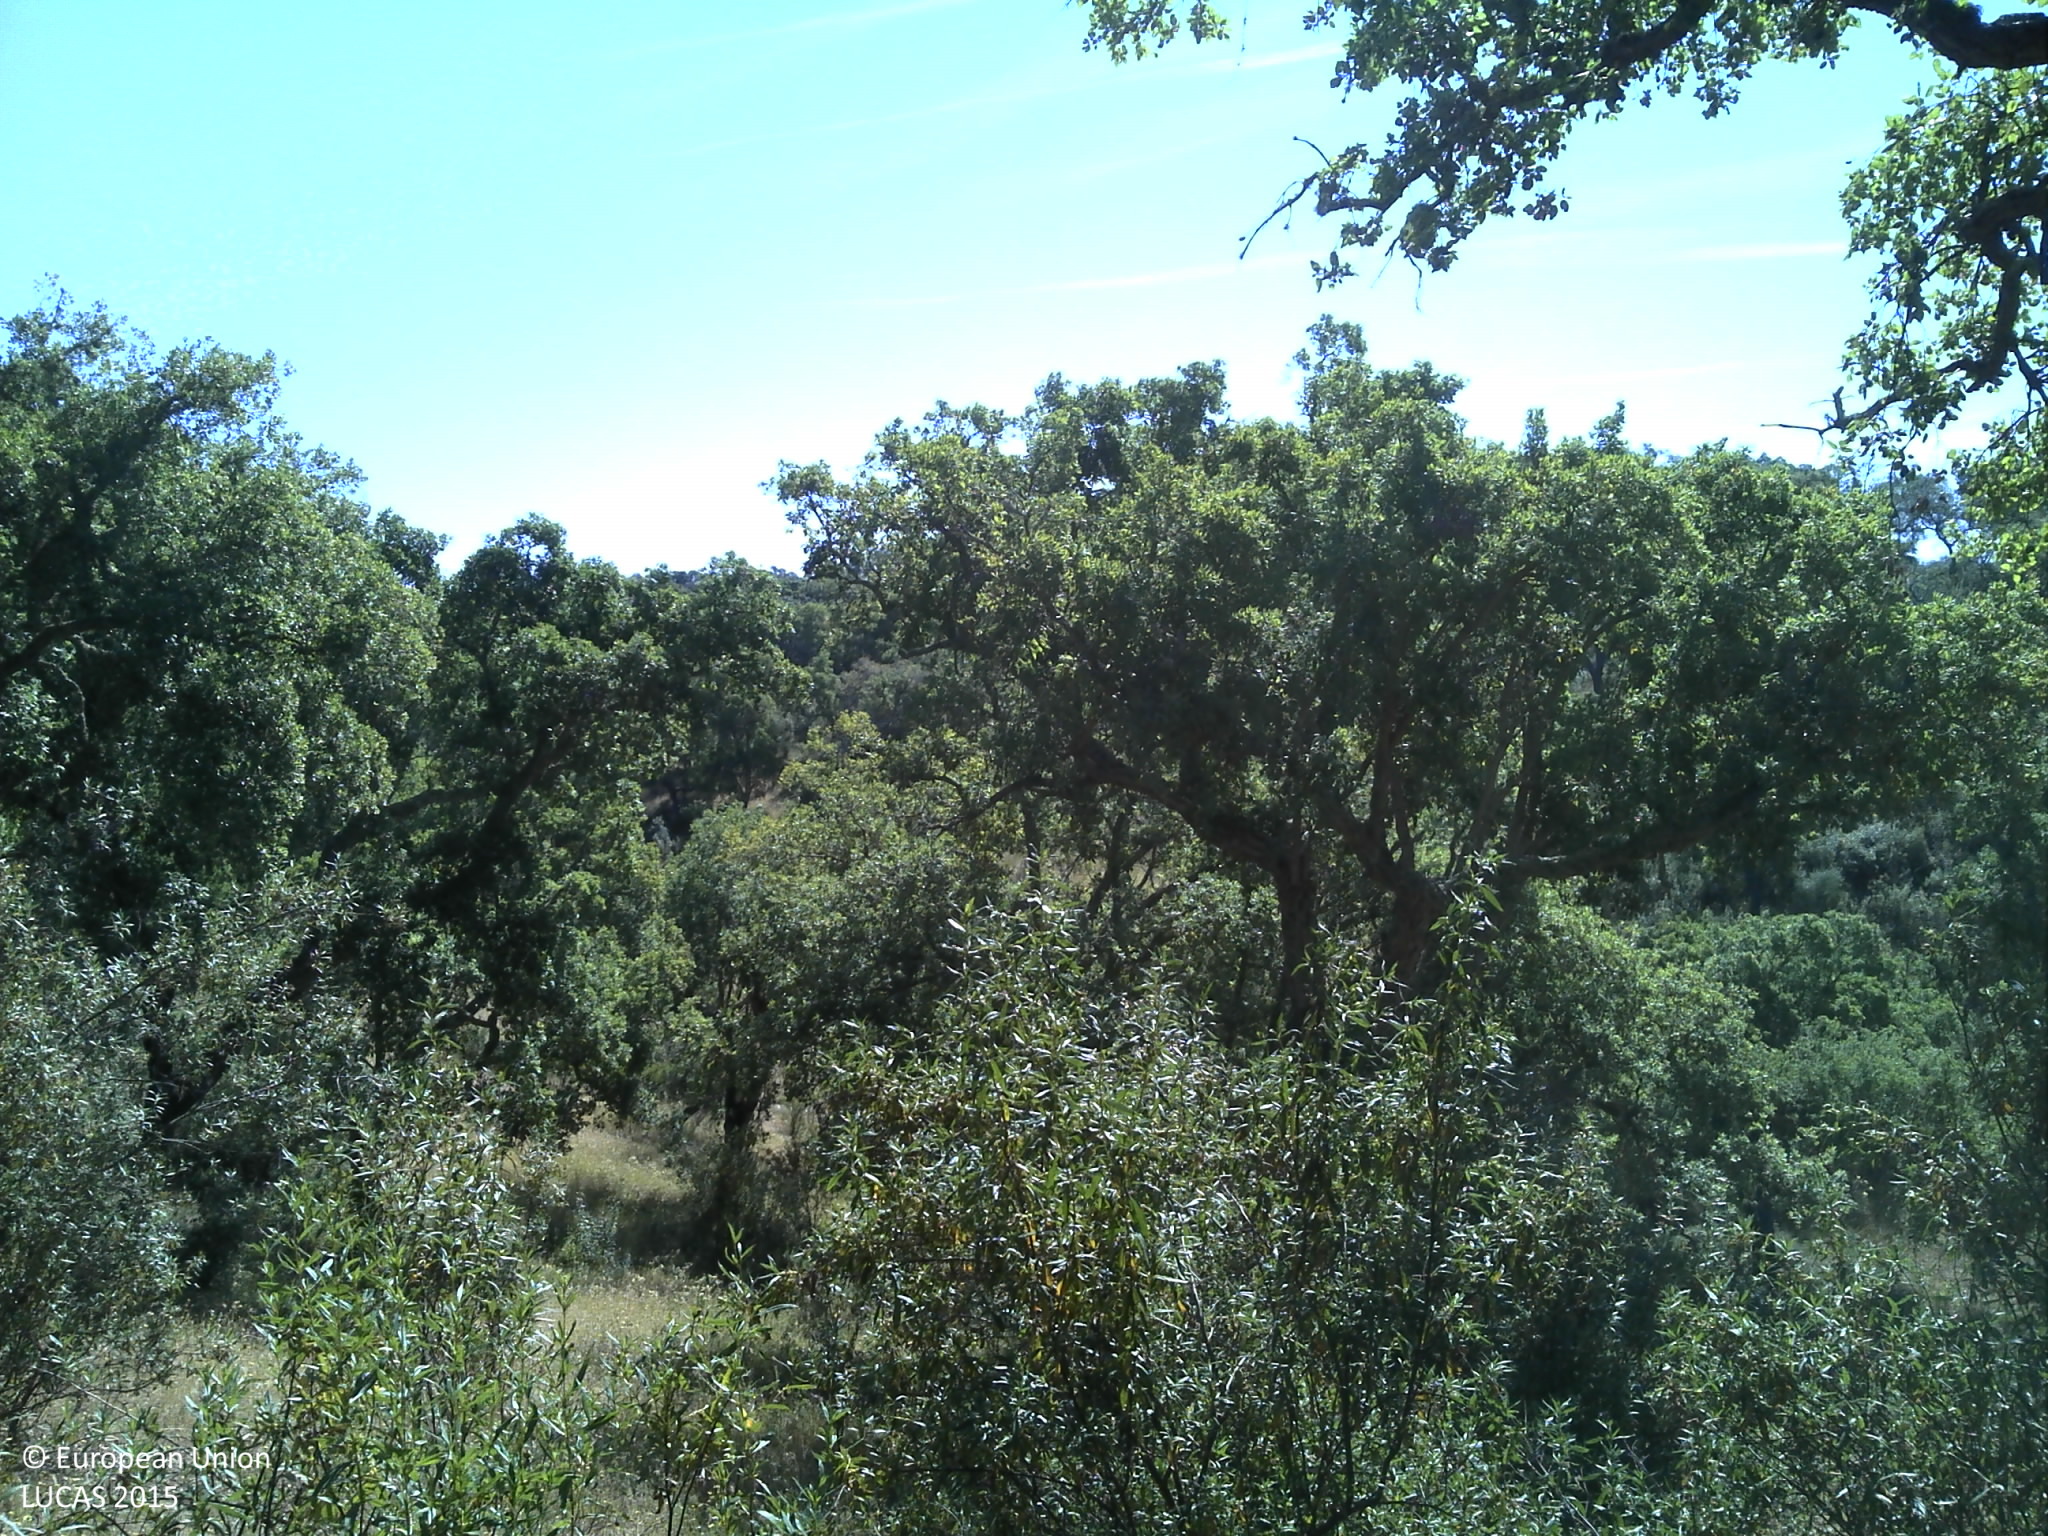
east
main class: Woodland
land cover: Broadleaved woodland
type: broadleaved evergreen forest
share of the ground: 25 - 50 %
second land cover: Shrubland without tree cover
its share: 25 - 50 %
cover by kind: broadleaved forest trees 40 %, herbaceous plants 25 %, unconsolidated bare surface 20 %, shrubs 15 %
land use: Forestry
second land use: Agriculture (excluding fallow land and kitchen gardens)
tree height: > 5 m
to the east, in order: Broadleaved woodland; Shrubland without tree cover; Broadleaved woodland; Rivers and streams; Broadleaved woodland
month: May
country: PT
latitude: 39.2201
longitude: -7.8766
